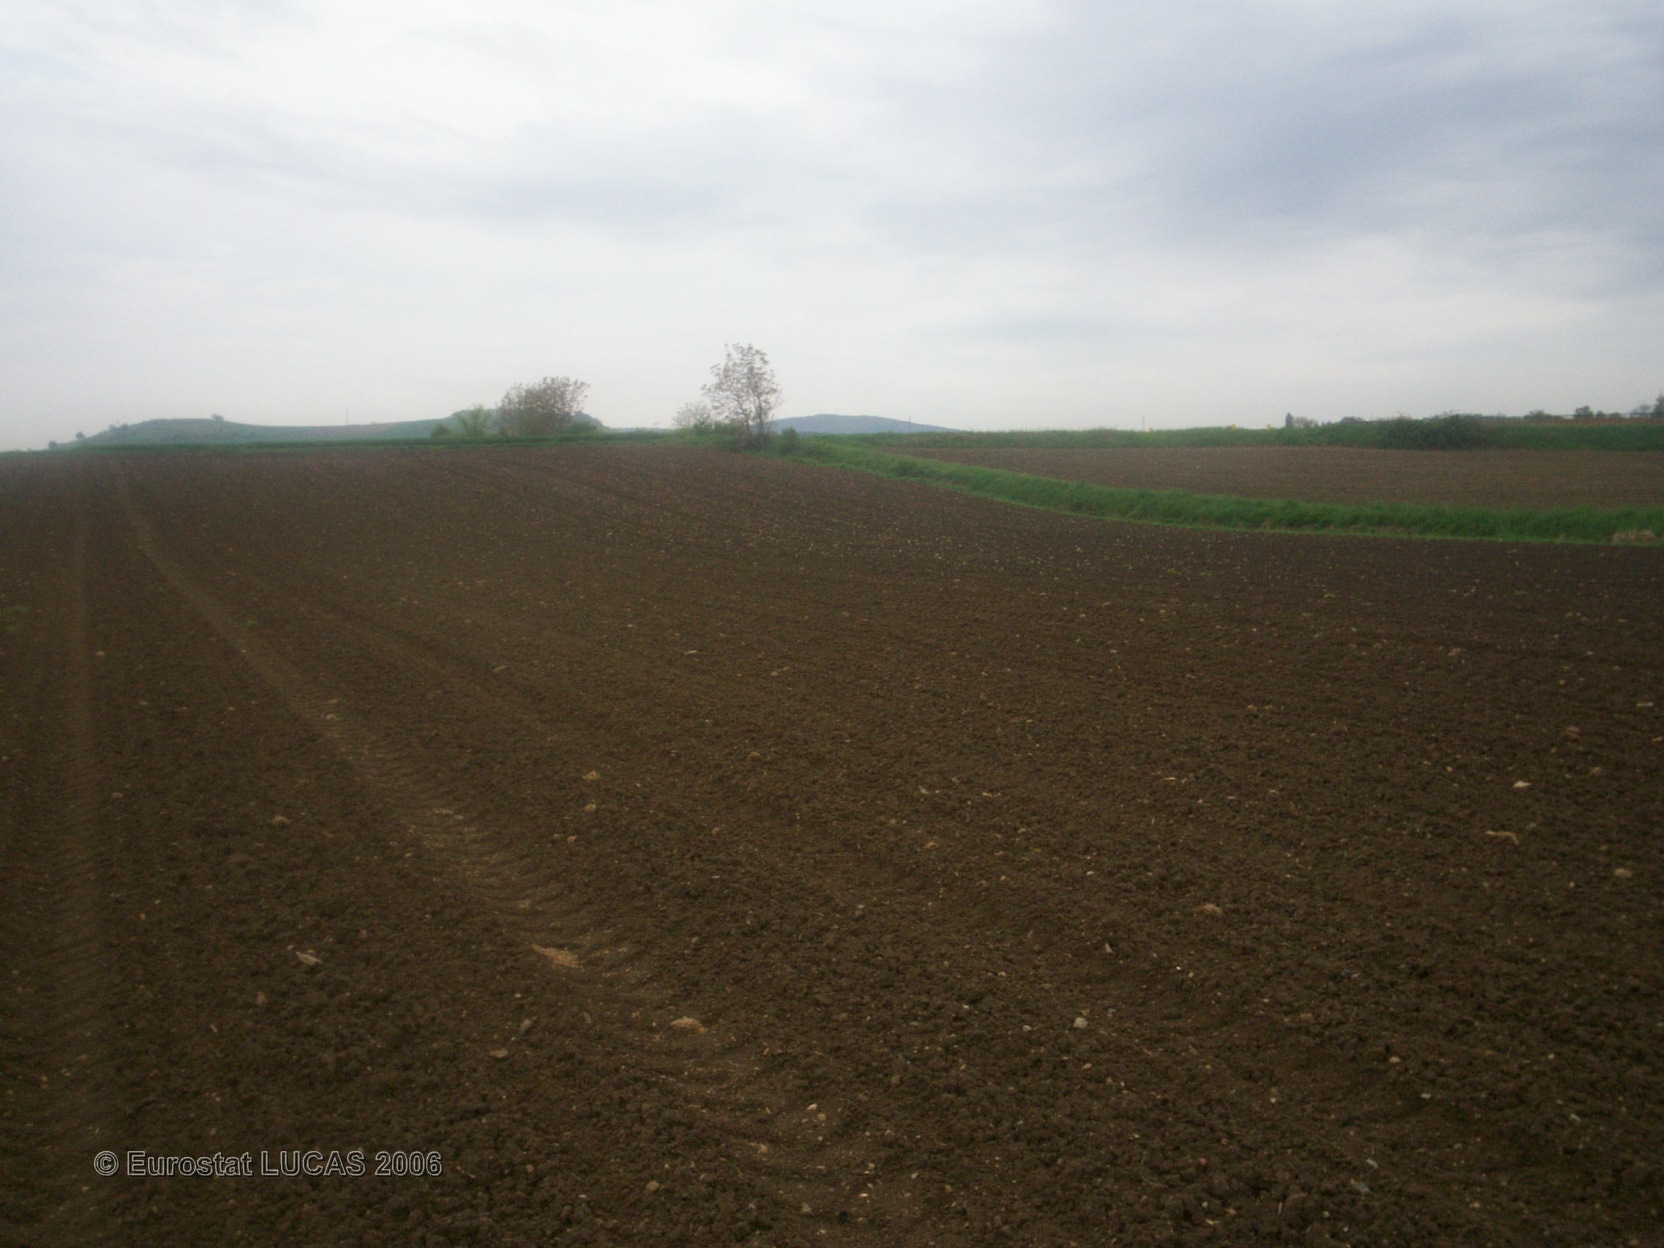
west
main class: Cropland
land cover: Maize
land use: Agriculture (excluding fallow land and kitchen gardens)
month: May
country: FR
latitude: 45.9866
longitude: 3.1444
